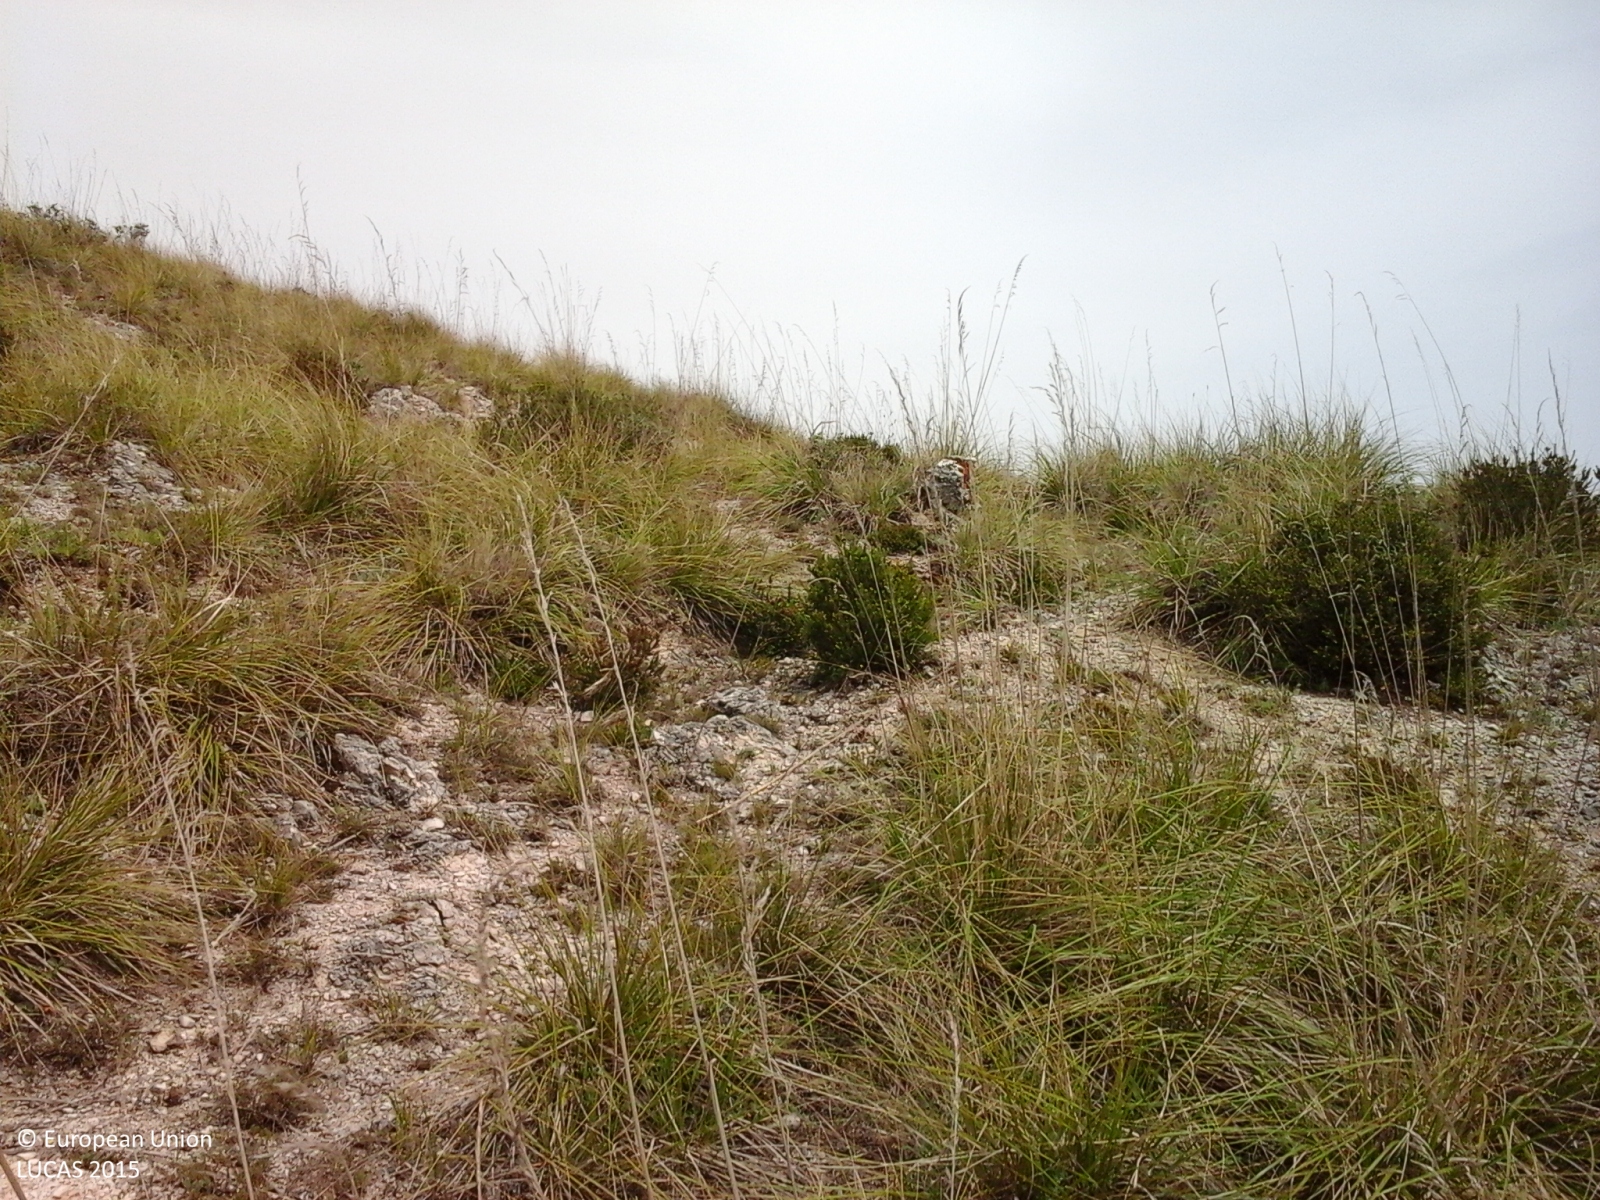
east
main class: Shrubland
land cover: Shrubland without tree cover
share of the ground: > 75 %
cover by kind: herbaceous plants 85 %, shrubs 15 %
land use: Semi-natural and natural areas not in use
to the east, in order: Shrubland without tree cover; Temporary grasslands; Shrubland with sparse tree cover; Temporary grasslands
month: May
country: IT
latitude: 37.6839
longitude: 13.4781
